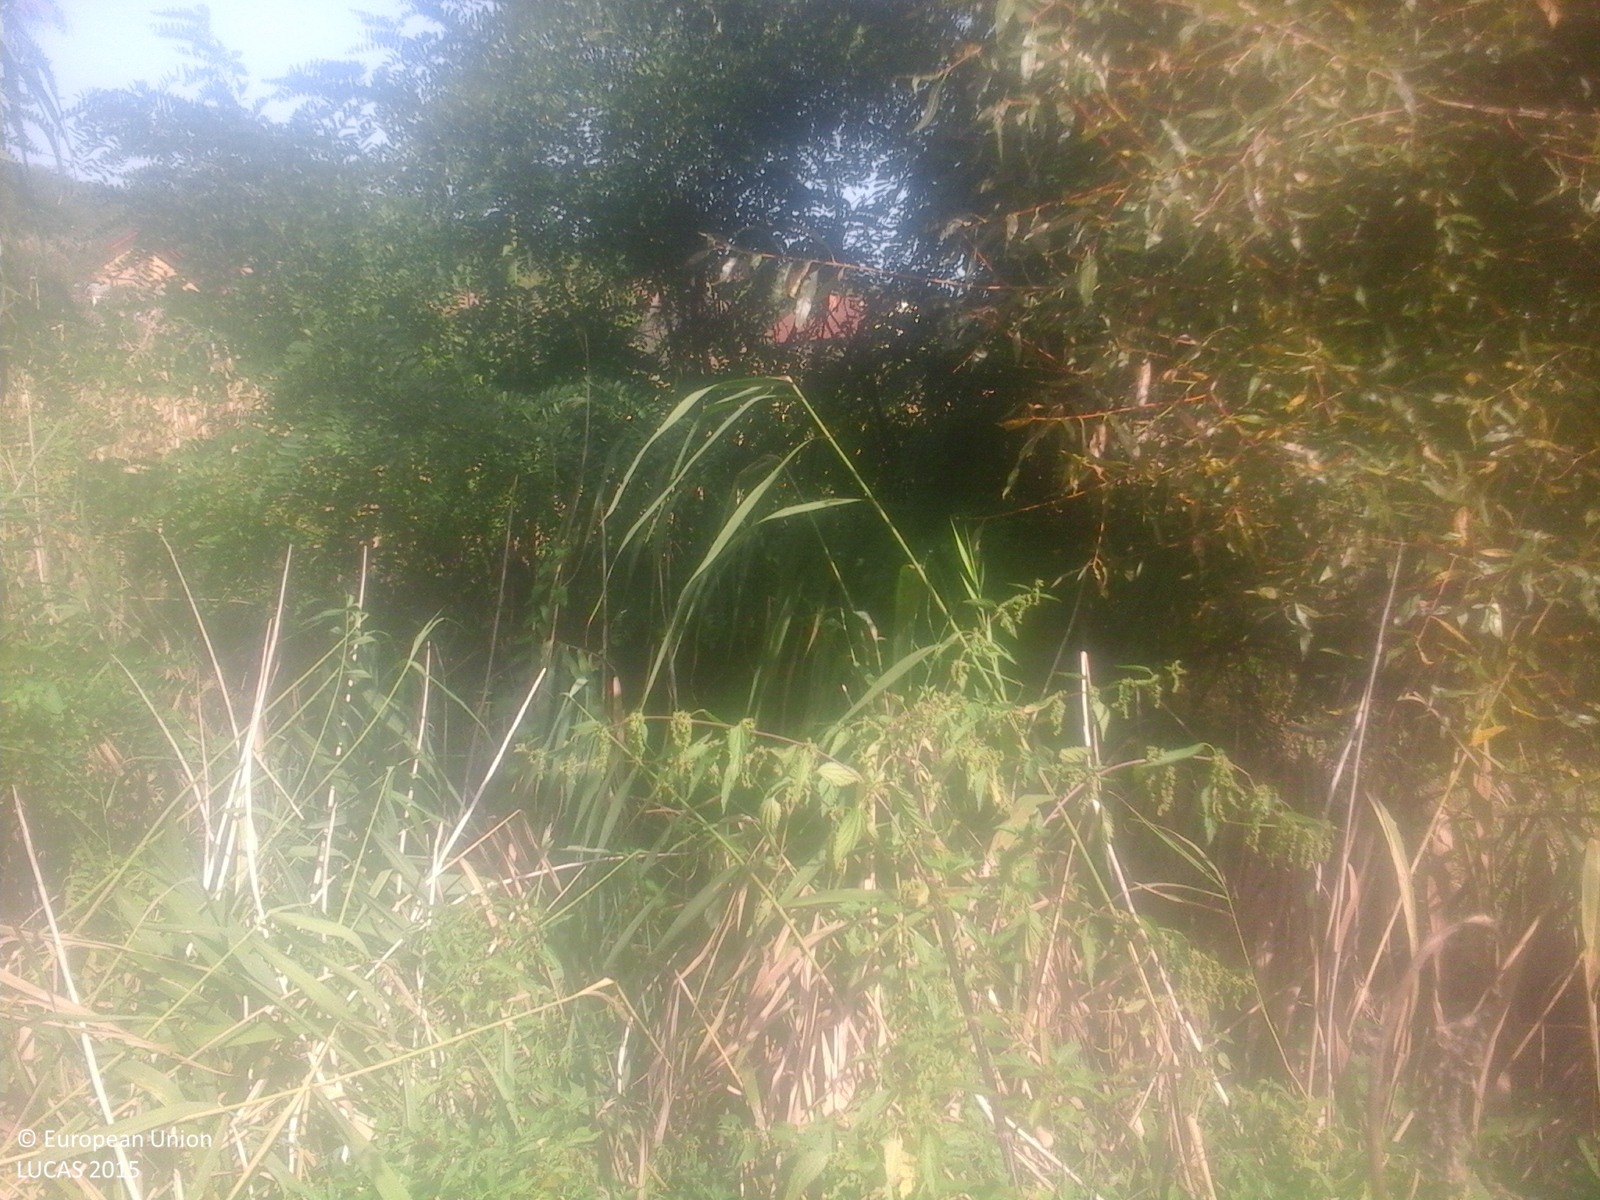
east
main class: Cropland
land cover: Maize
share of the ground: > 75 %
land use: Agriculture (excluding fallow land and kitchen gardens)
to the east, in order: Ditches and canals; Abandoned hedges; Maize; Artificial constructions in urban areas
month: September
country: RO
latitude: 46.8977
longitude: 24.3278
